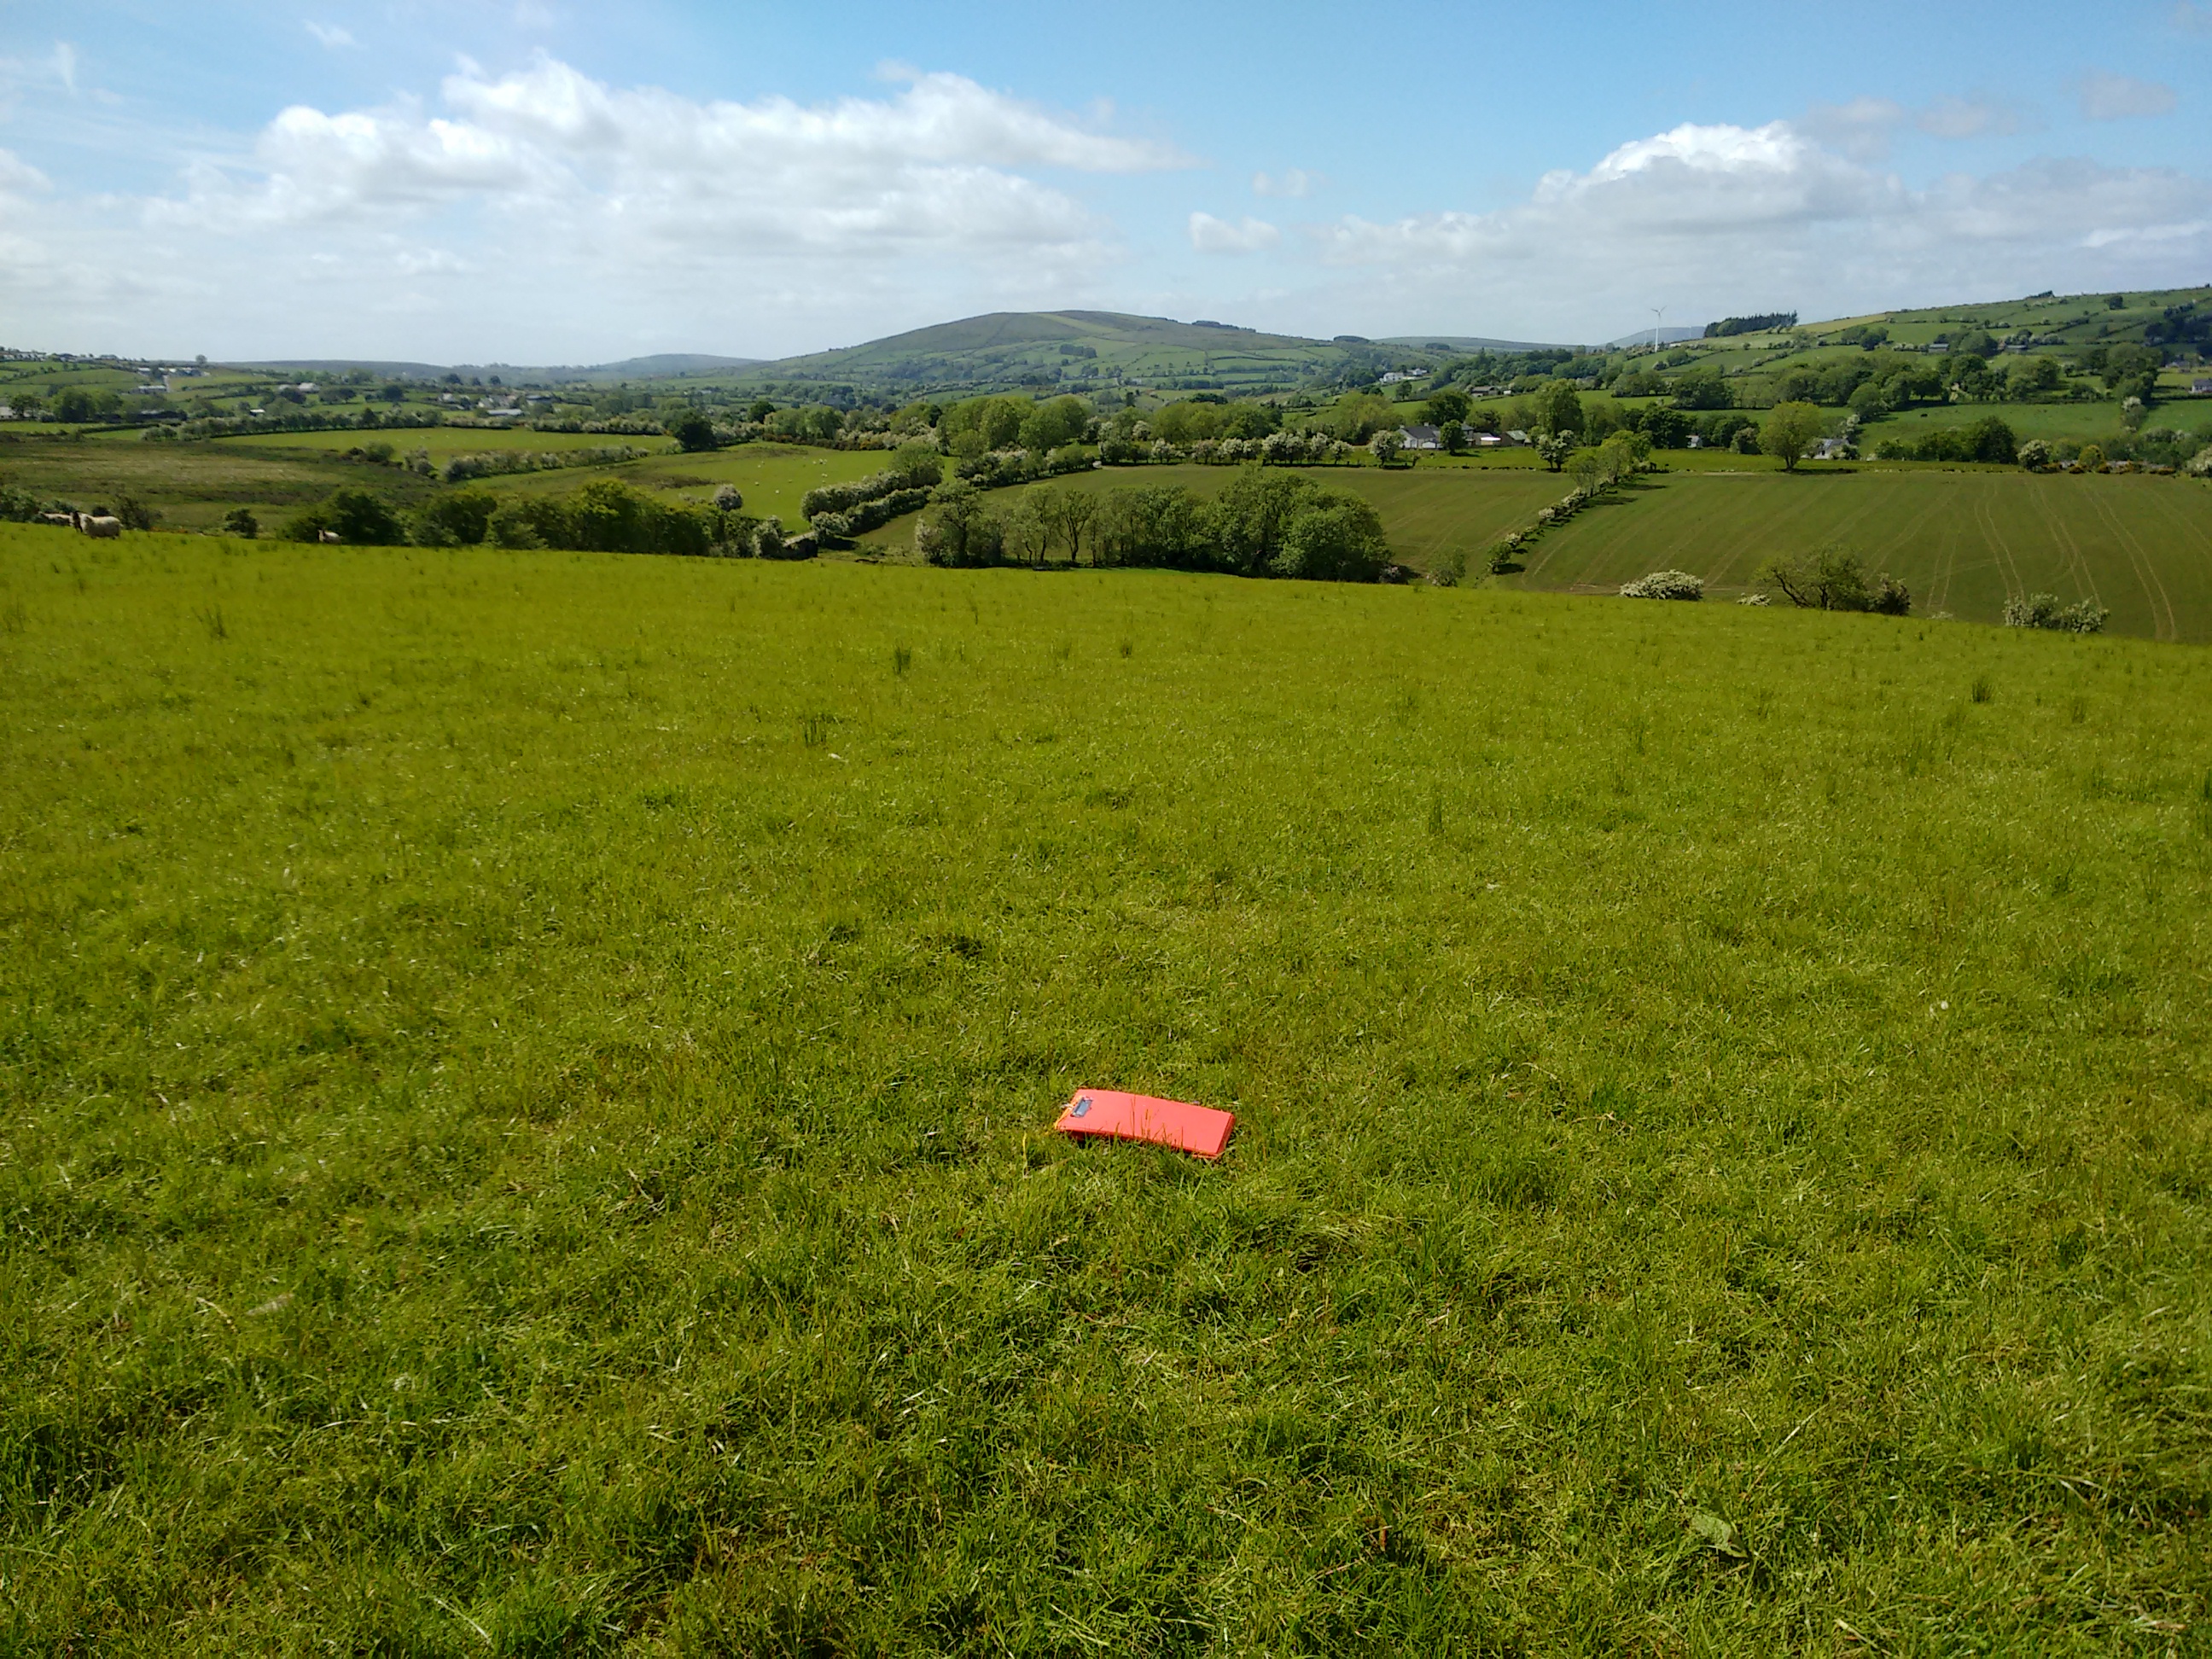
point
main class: Grassland
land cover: Grassland without tree/shrub cover
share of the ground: > 75 %
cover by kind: herbaceous plants 100 %
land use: Agriculture (excluding fallow land and kitchen gardens)
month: June
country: GB
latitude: 54.8598
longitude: -7.1069
